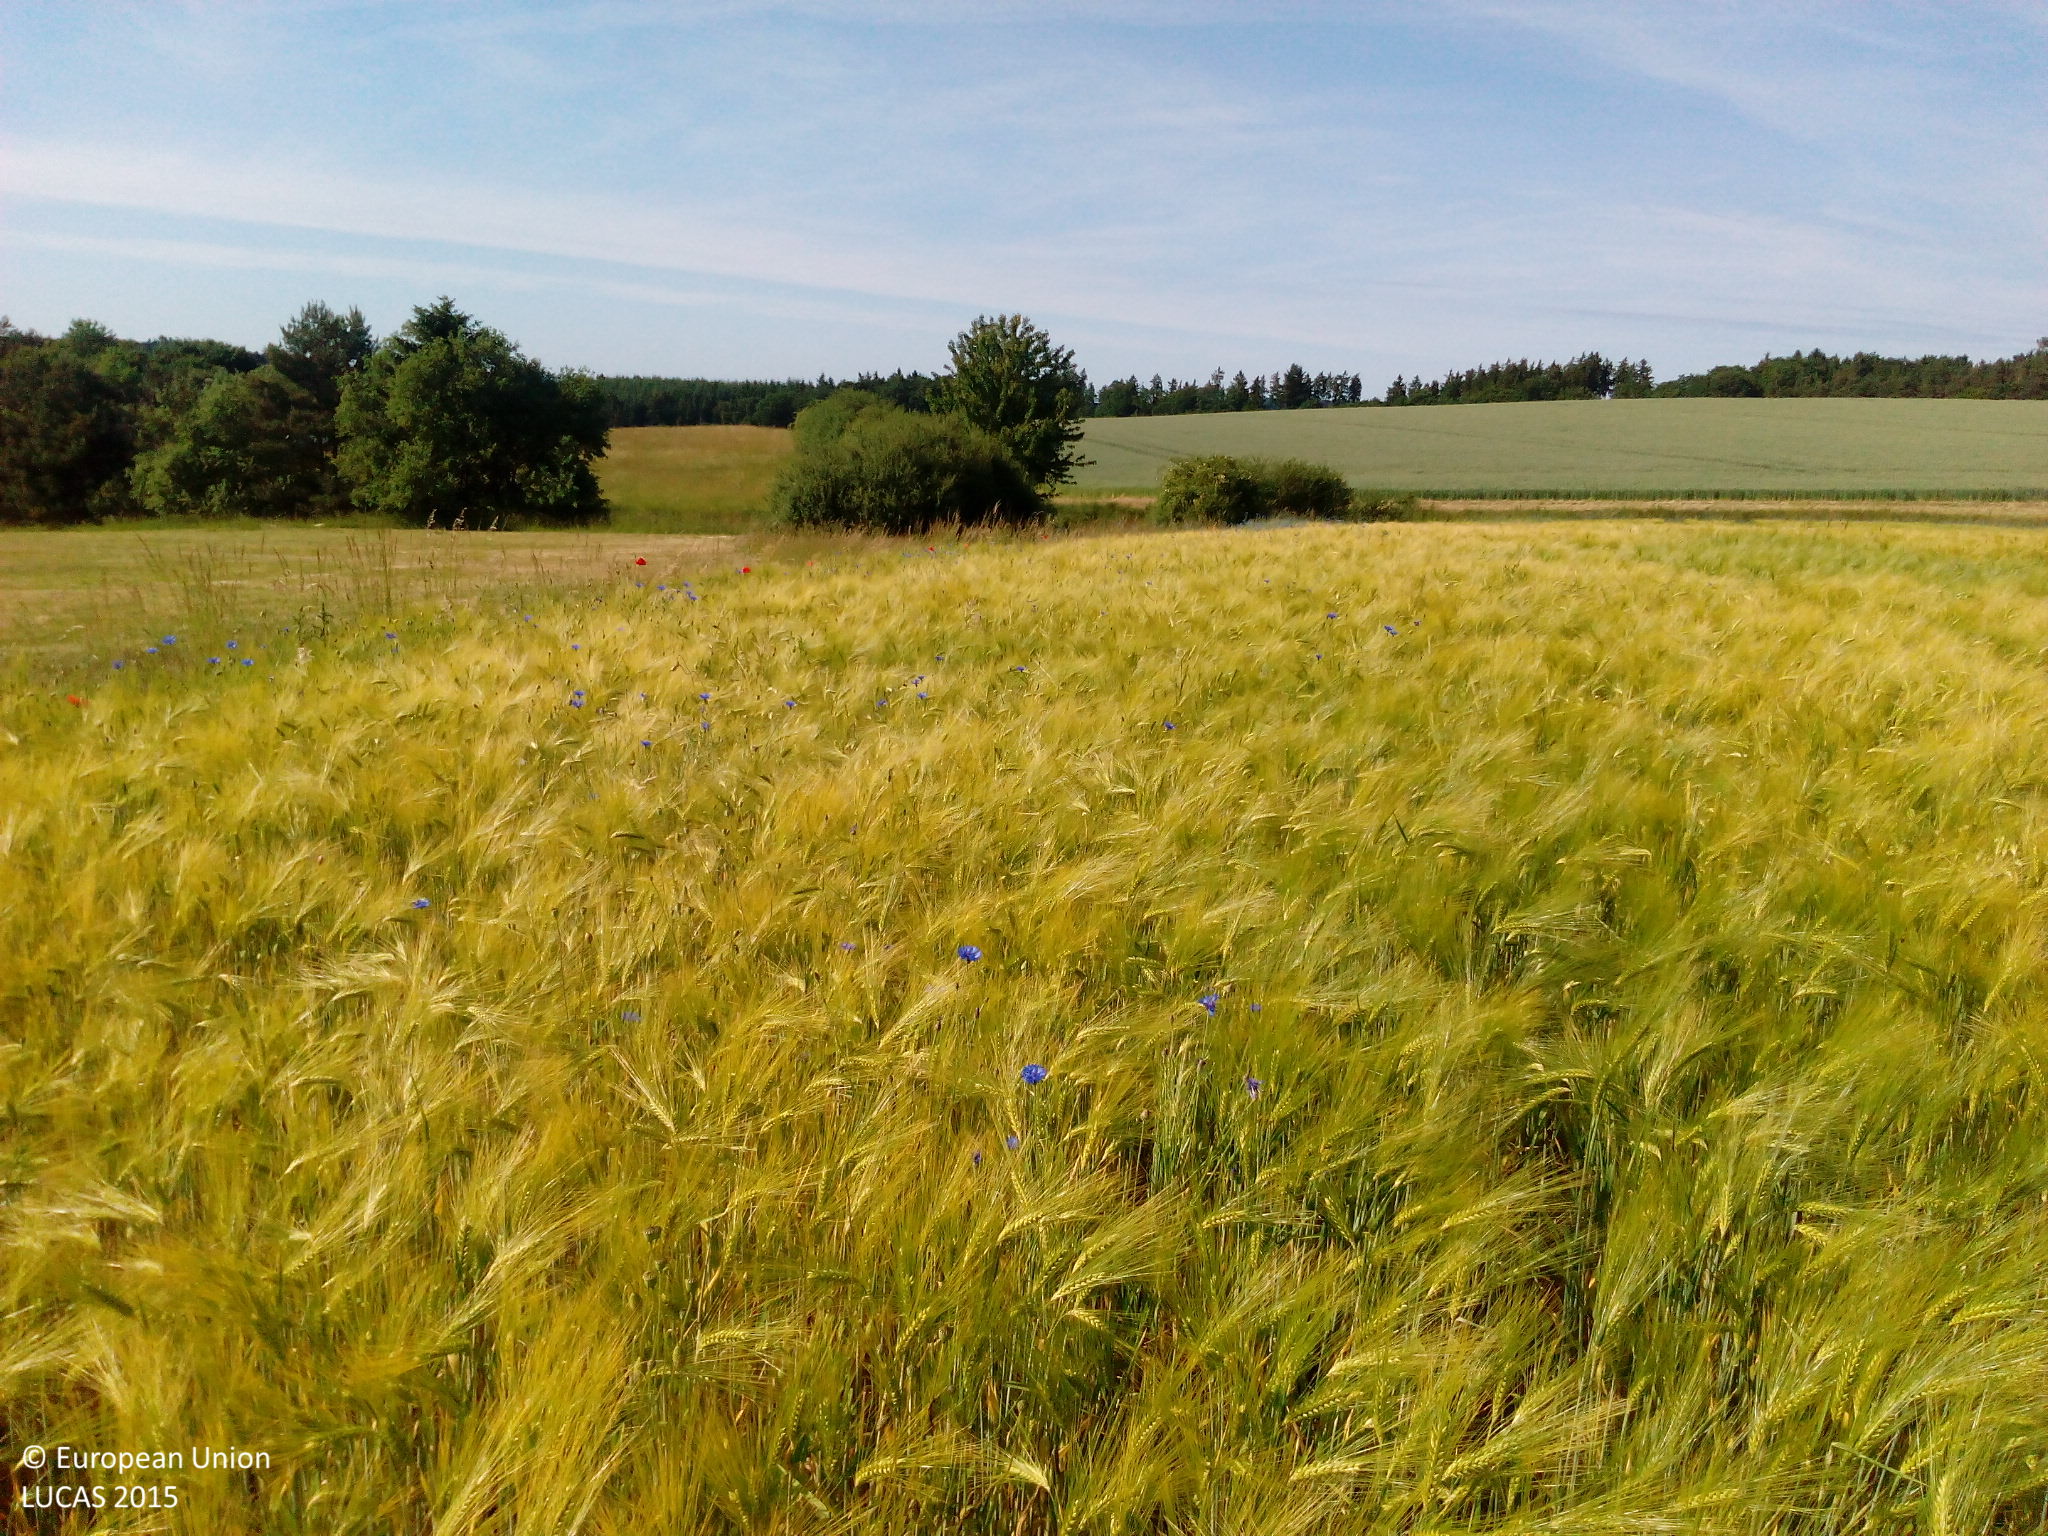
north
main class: Cropland
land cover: Barley
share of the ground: > 75 %
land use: Agriculture (excluding fallow land and kitchen gardens)
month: June
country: DE
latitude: 50.1870
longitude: 8.1376
